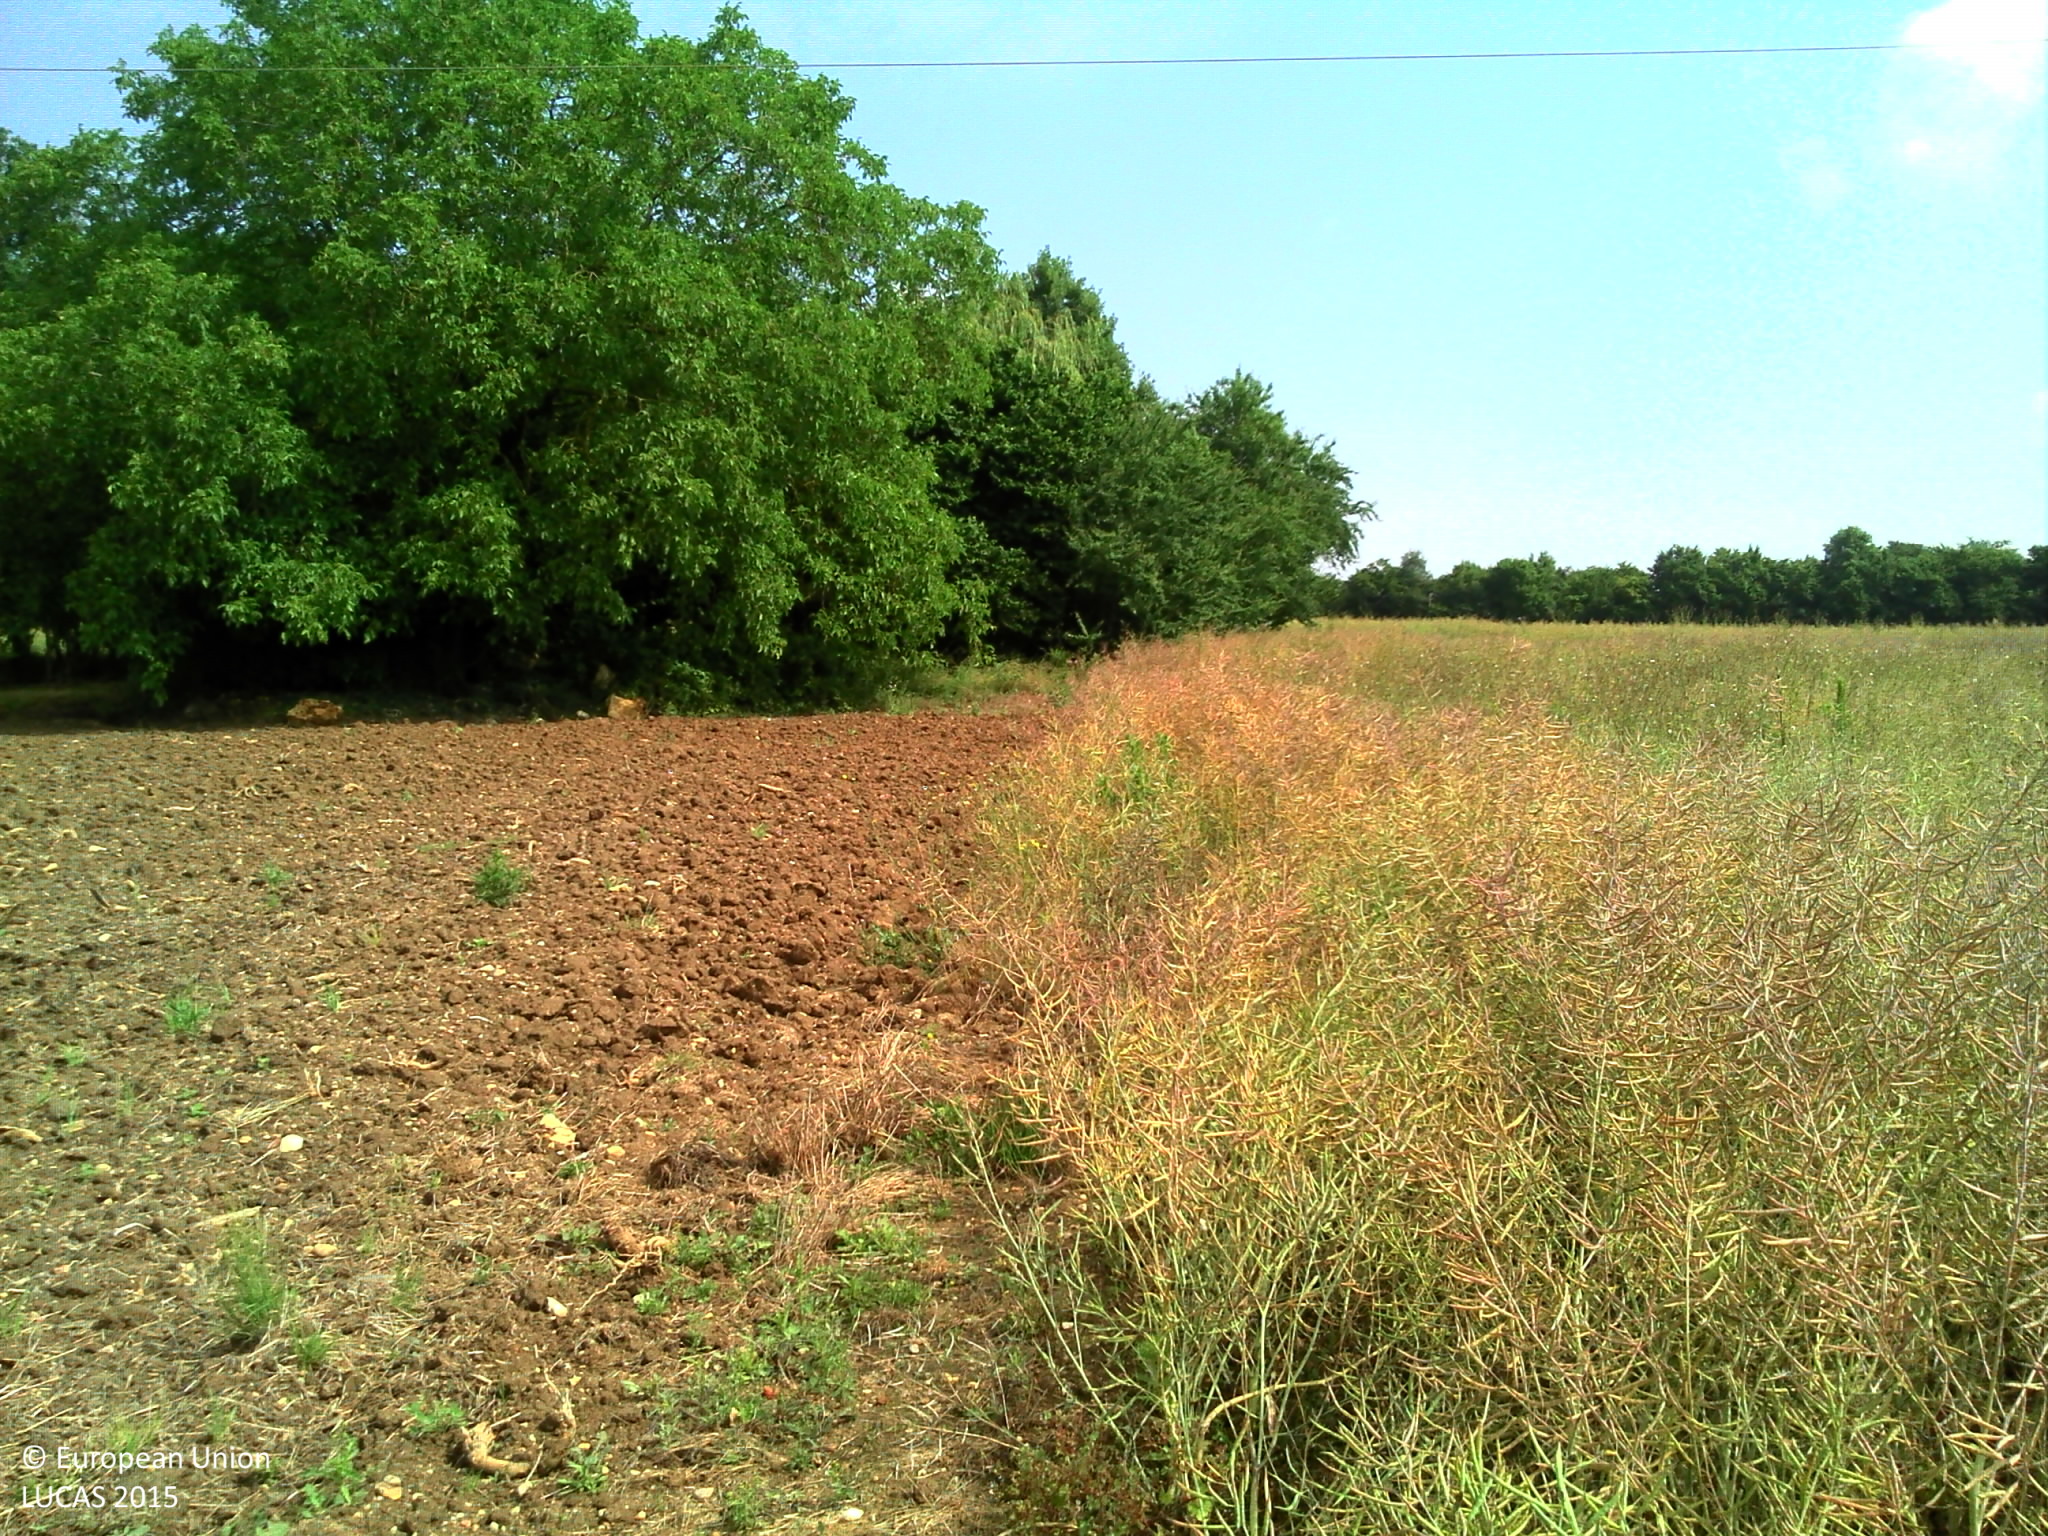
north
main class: Cropland
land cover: Rape and turnip rape
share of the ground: > 75 %
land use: Agriculture (excluding fallow land and kitchen gardens)
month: June
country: FR
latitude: 46.5756
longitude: 0.8643
